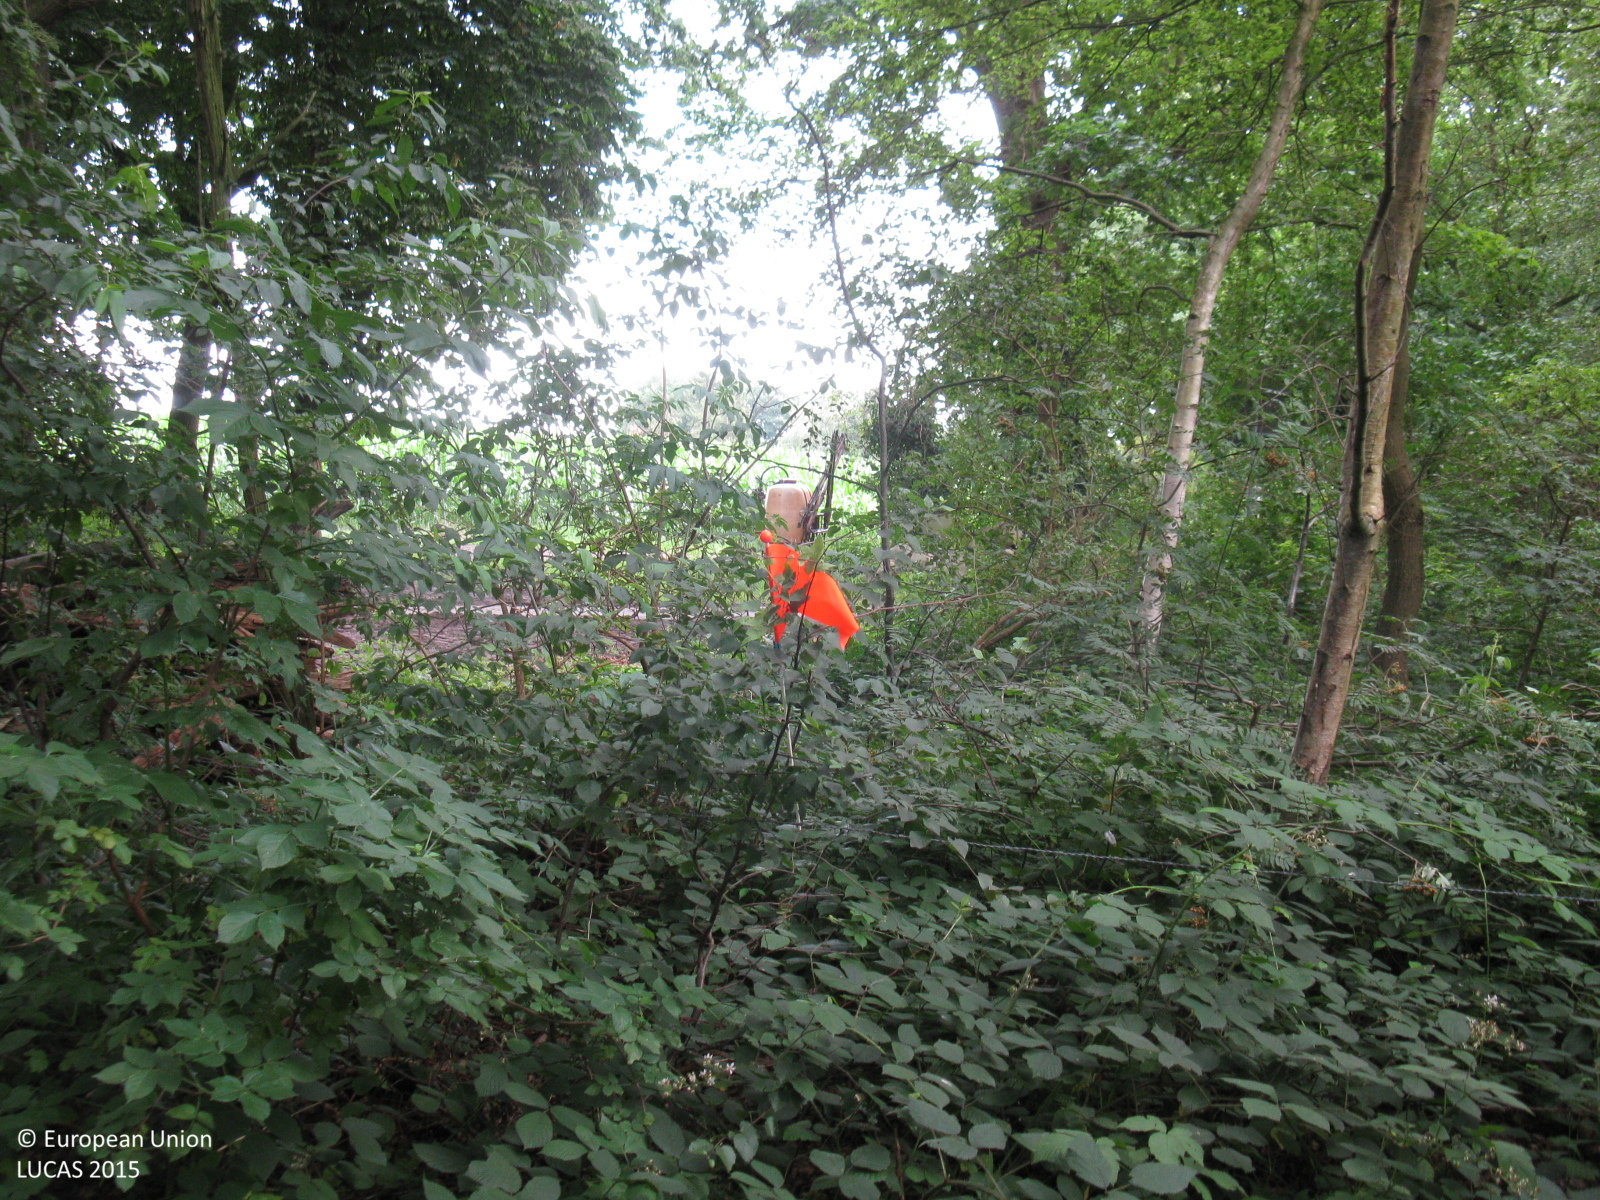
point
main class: Woodland
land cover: Broadleaved woodland
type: mesophytic deciduous forest
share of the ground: > 75 %
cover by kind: broadleaved forest trees 100 %
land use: Semi-natural and natural areas not in use
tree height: > 5 m
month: July
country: DE
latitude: 53.0241
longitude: 7.8984
